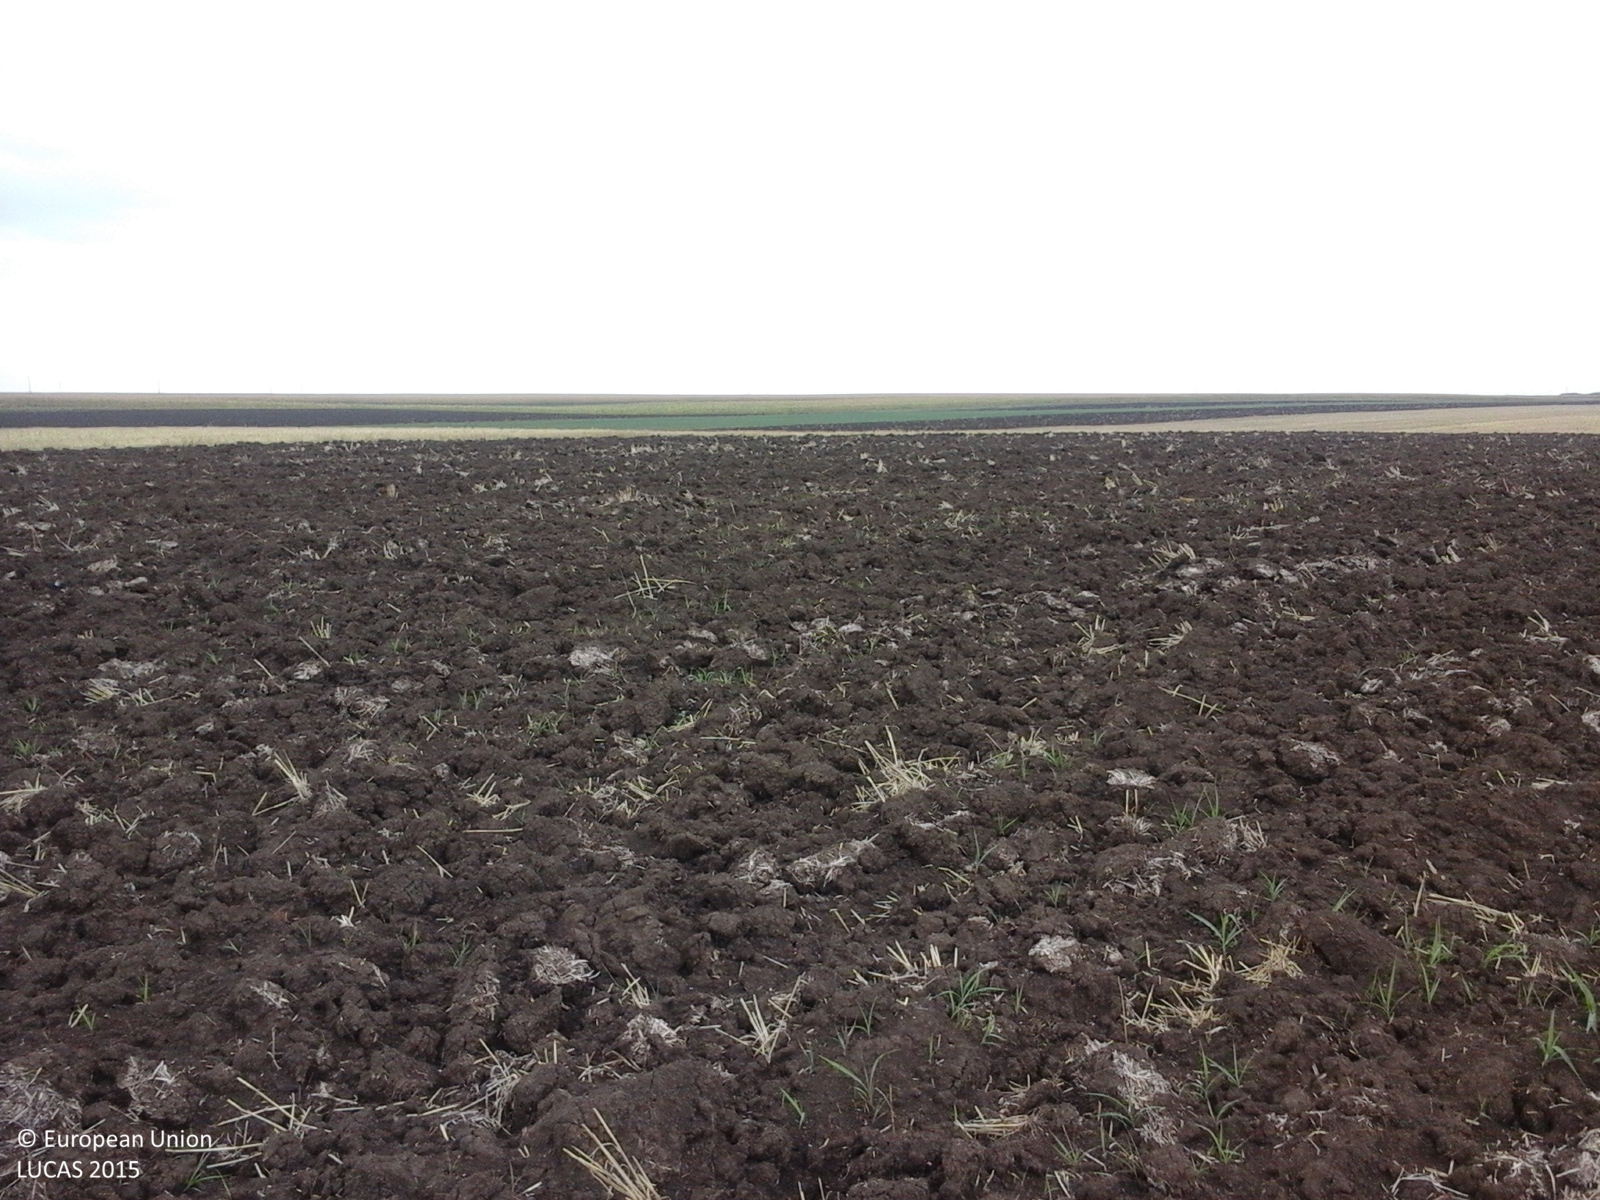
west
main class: Cropland
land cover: Common wheat
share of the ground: < 10 %
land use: Agriculture (excluding fallow land and kitchen gardens)
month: August
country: RO
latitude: 45.9449
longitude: 21.0067
